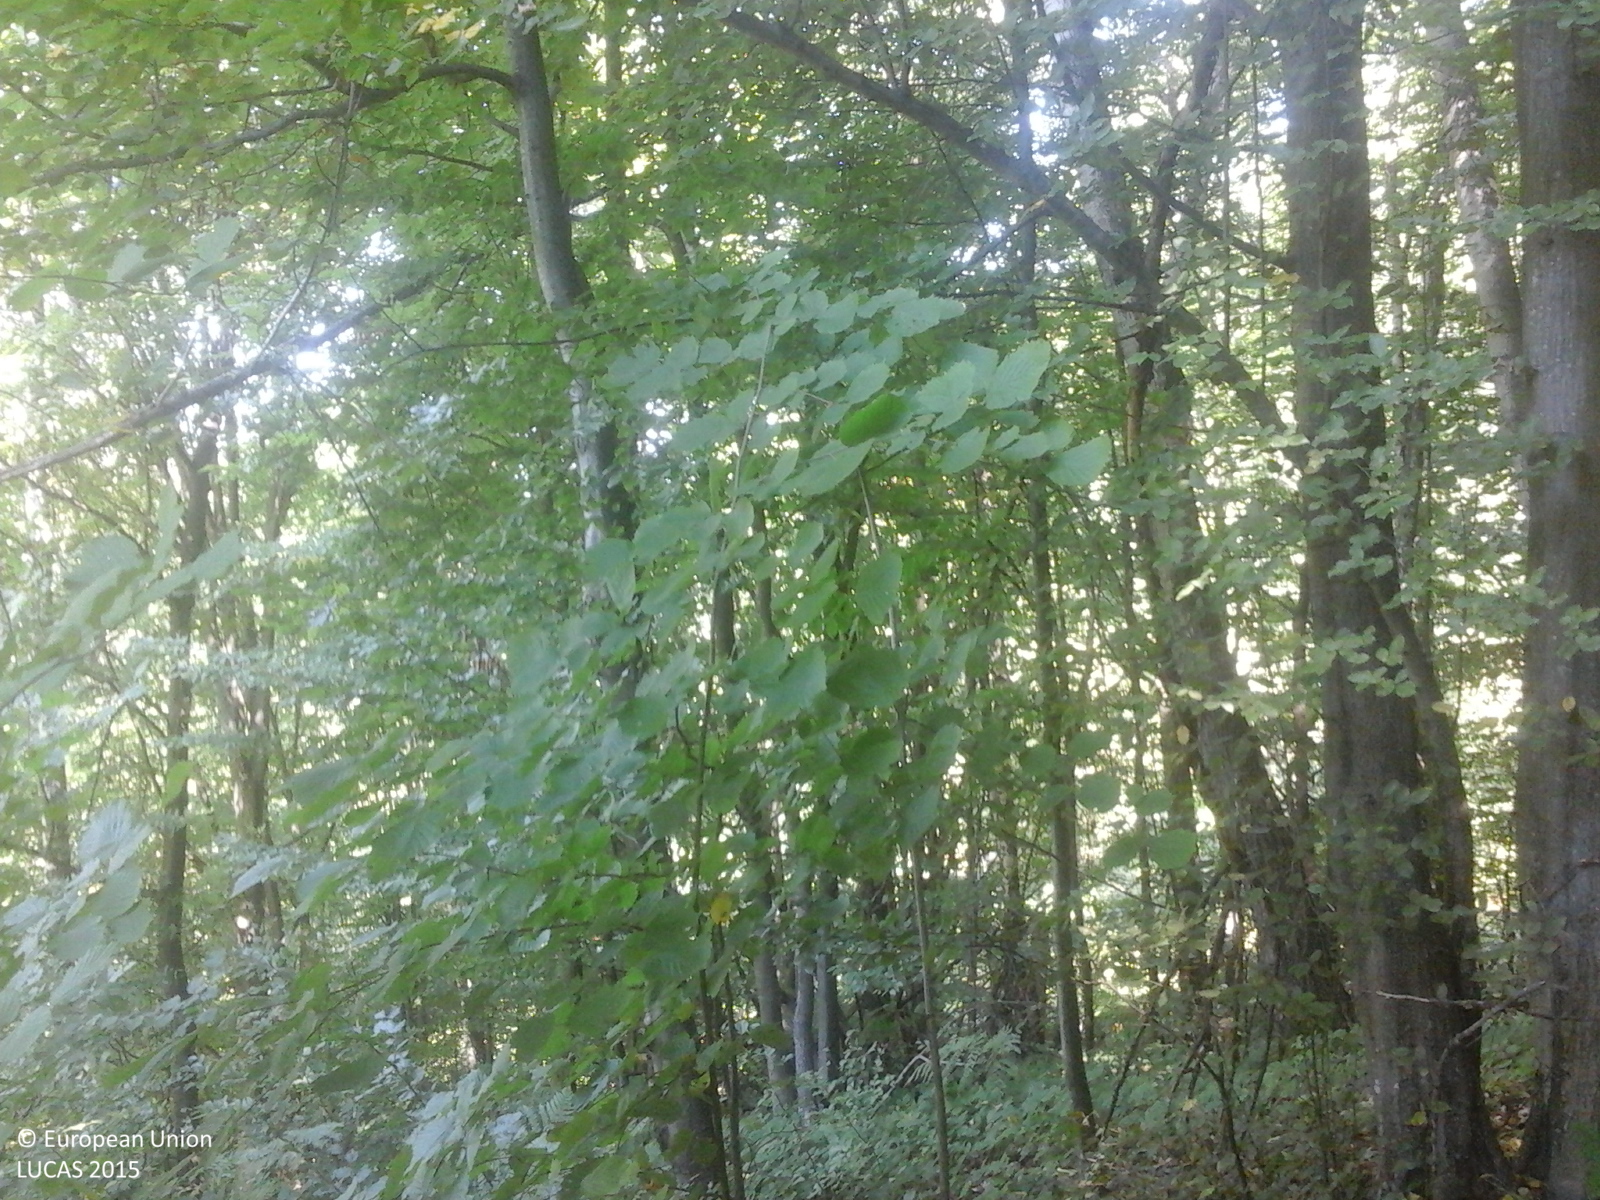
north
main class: Woodland
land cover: Broadleaved woodland
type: mesophytic deciduous forest
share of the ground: > 75 %
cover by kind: broadleaved forest trees 100 %
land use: Forestry
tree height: > 5 m
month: August
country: RO
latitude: 46.1471
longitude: 22.4648
